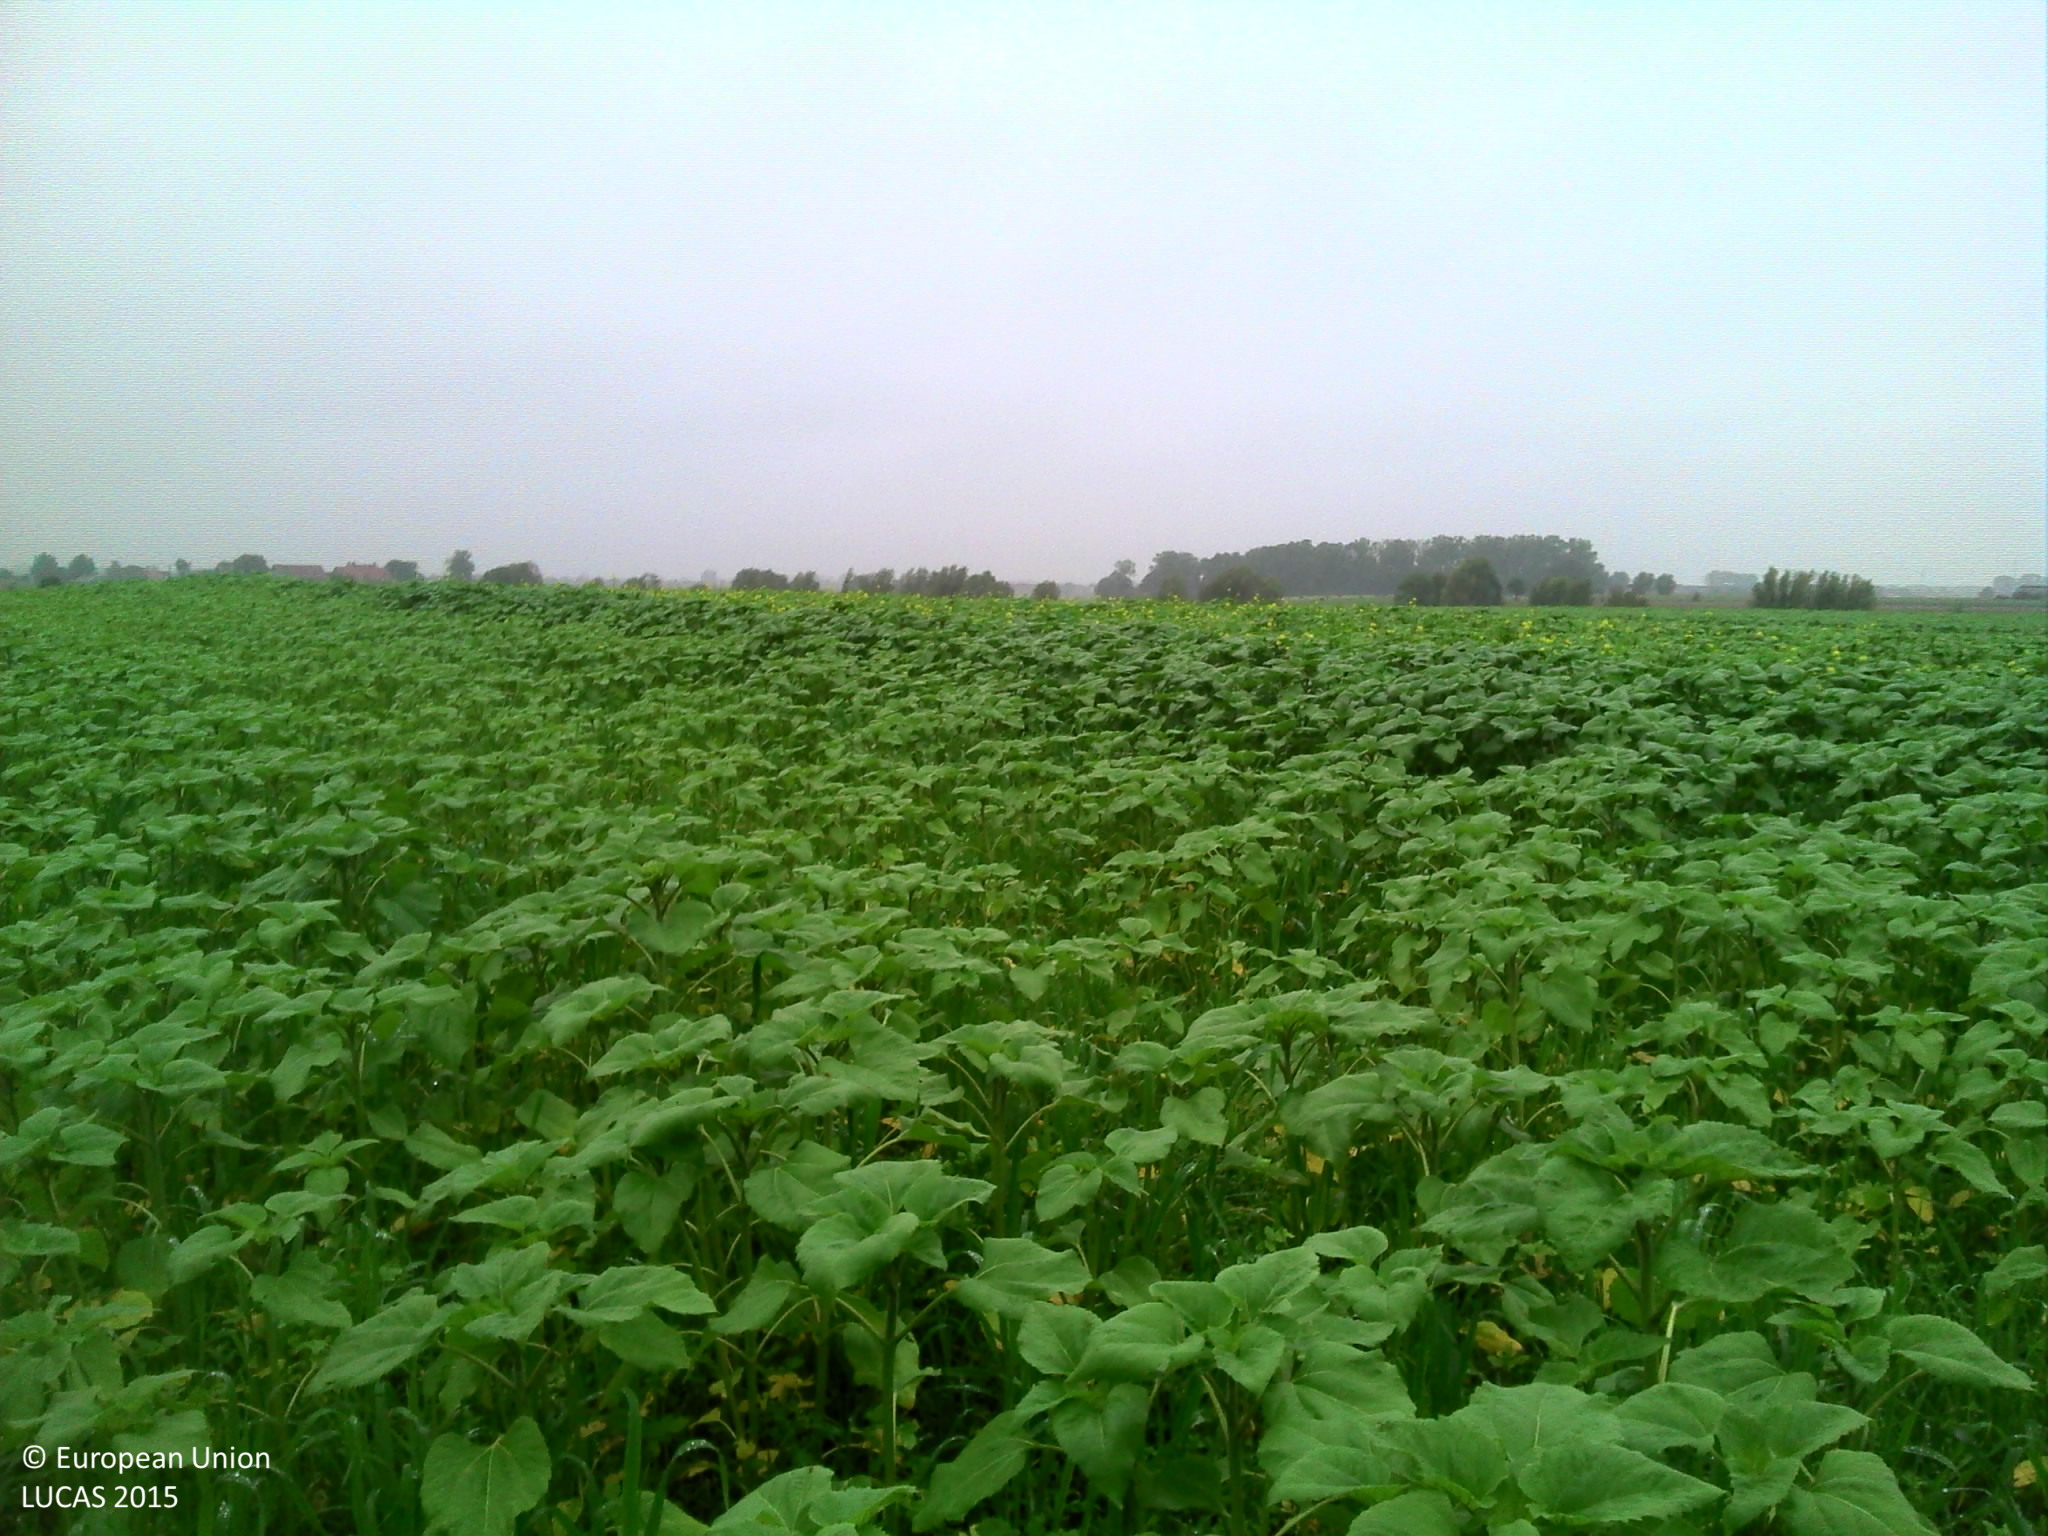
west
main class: Grassland
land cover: Grassland without tree/shrub cover
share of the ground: > 75 %
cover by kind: herbaceous plants 100 %
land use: Agriculture (excluding fallow land and kitchen gardens)
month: October
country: BE
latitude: 50.9368
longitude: 2.8884
